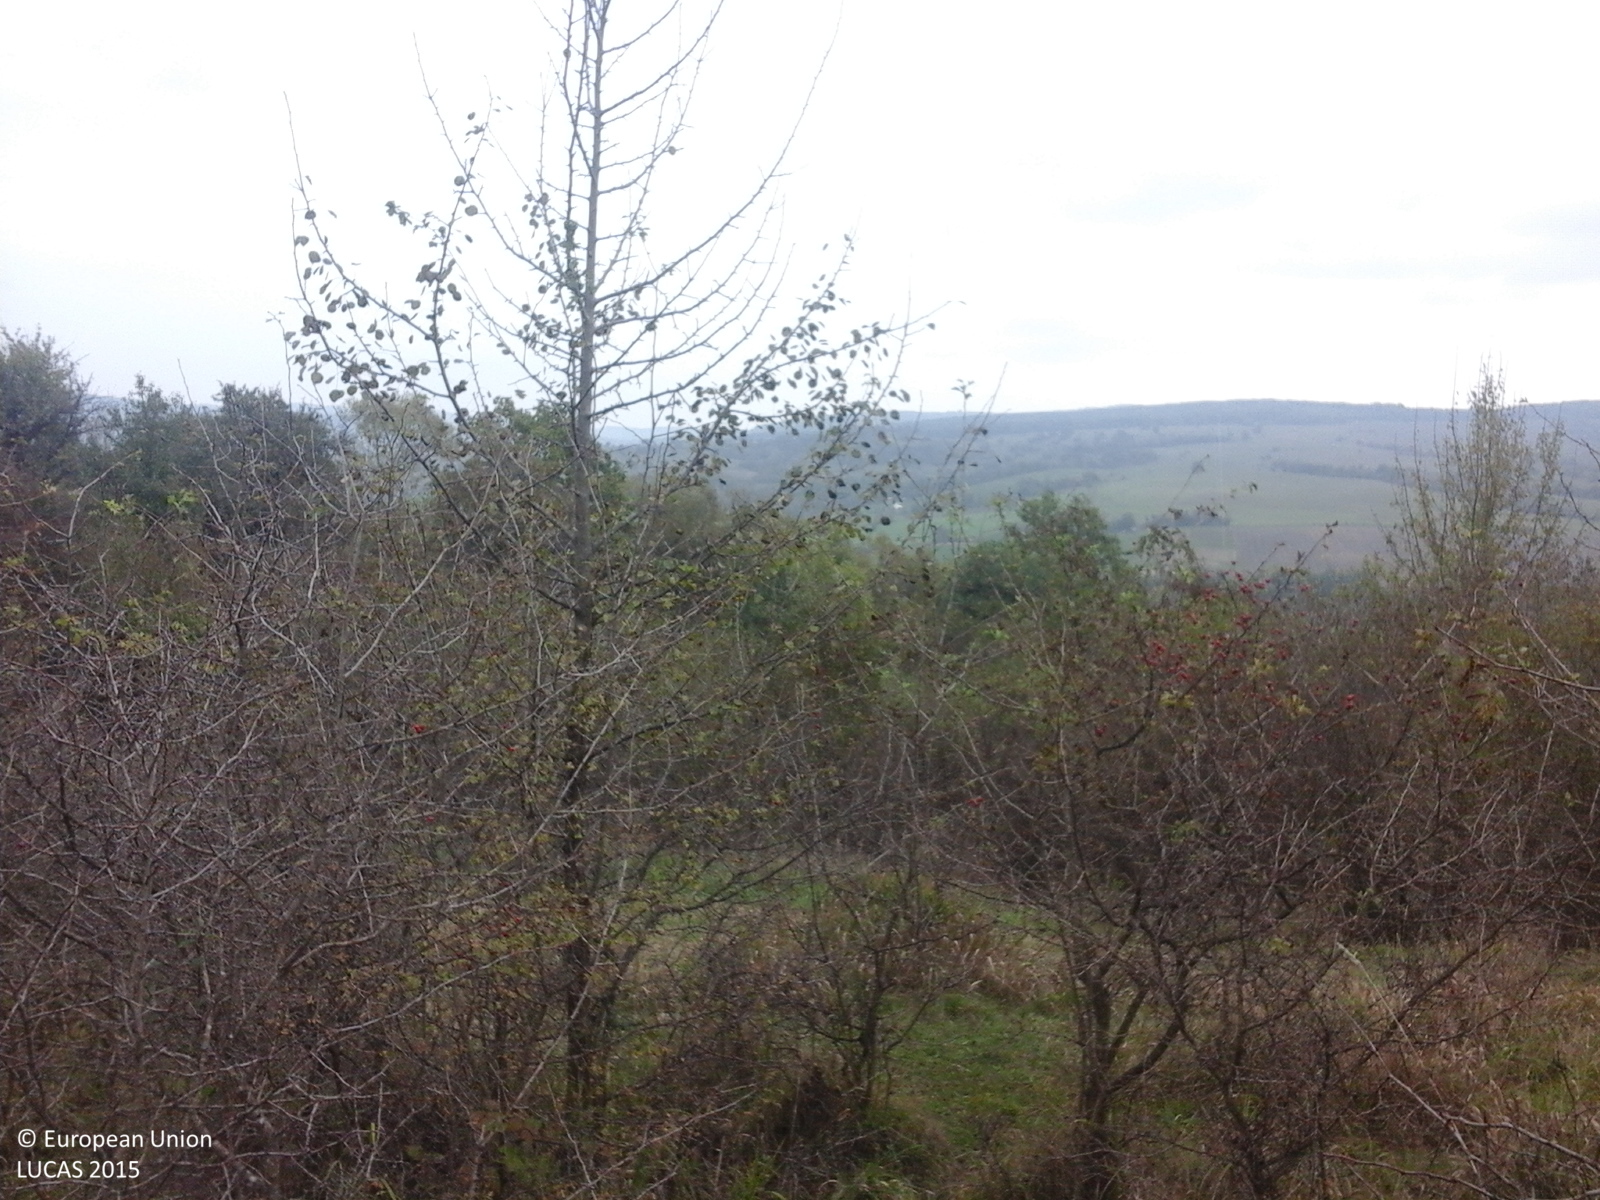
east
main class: Shrubland
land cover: Shrubland with sparse tree cover
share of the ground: > 75 %
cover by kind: shrubs 60 %, herbaceous plants 35 %, broadleaved forest trees 5 %
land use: Fallow land
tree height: < 5 m
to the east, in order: Shrubland with sparse tree cover; Tracks; Shrubland with sparse tree cover; Ditches and canals; Broadleaved woodland; Tracks; Grassland with sparse tree/shrub cover; Spontaneously vegetated surfaces
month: October
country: RO
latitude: 46.1081
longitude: 25.0119
